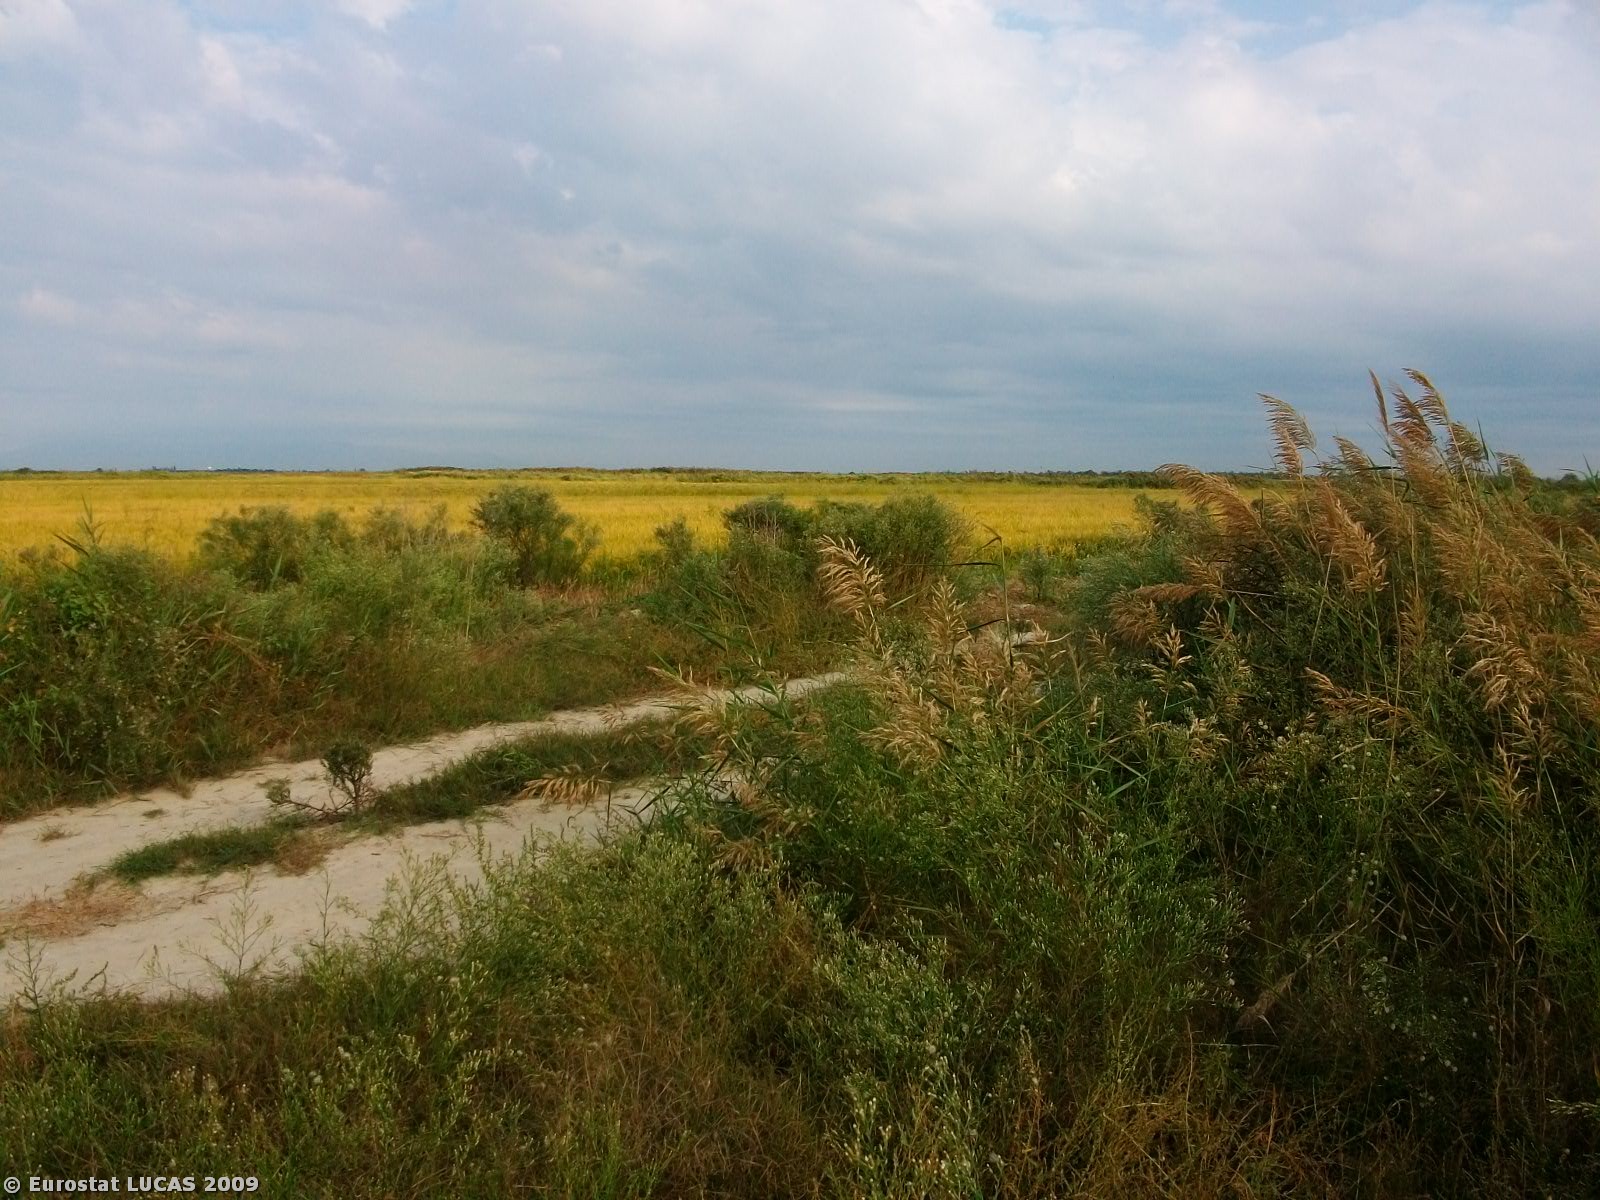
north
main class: Cropland
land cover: Rice
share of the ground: > 75 %
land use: Agriculture (excluding fallow land and kitchen gardens)
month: June
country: GR
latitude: 40.5275
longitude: 22.6214
